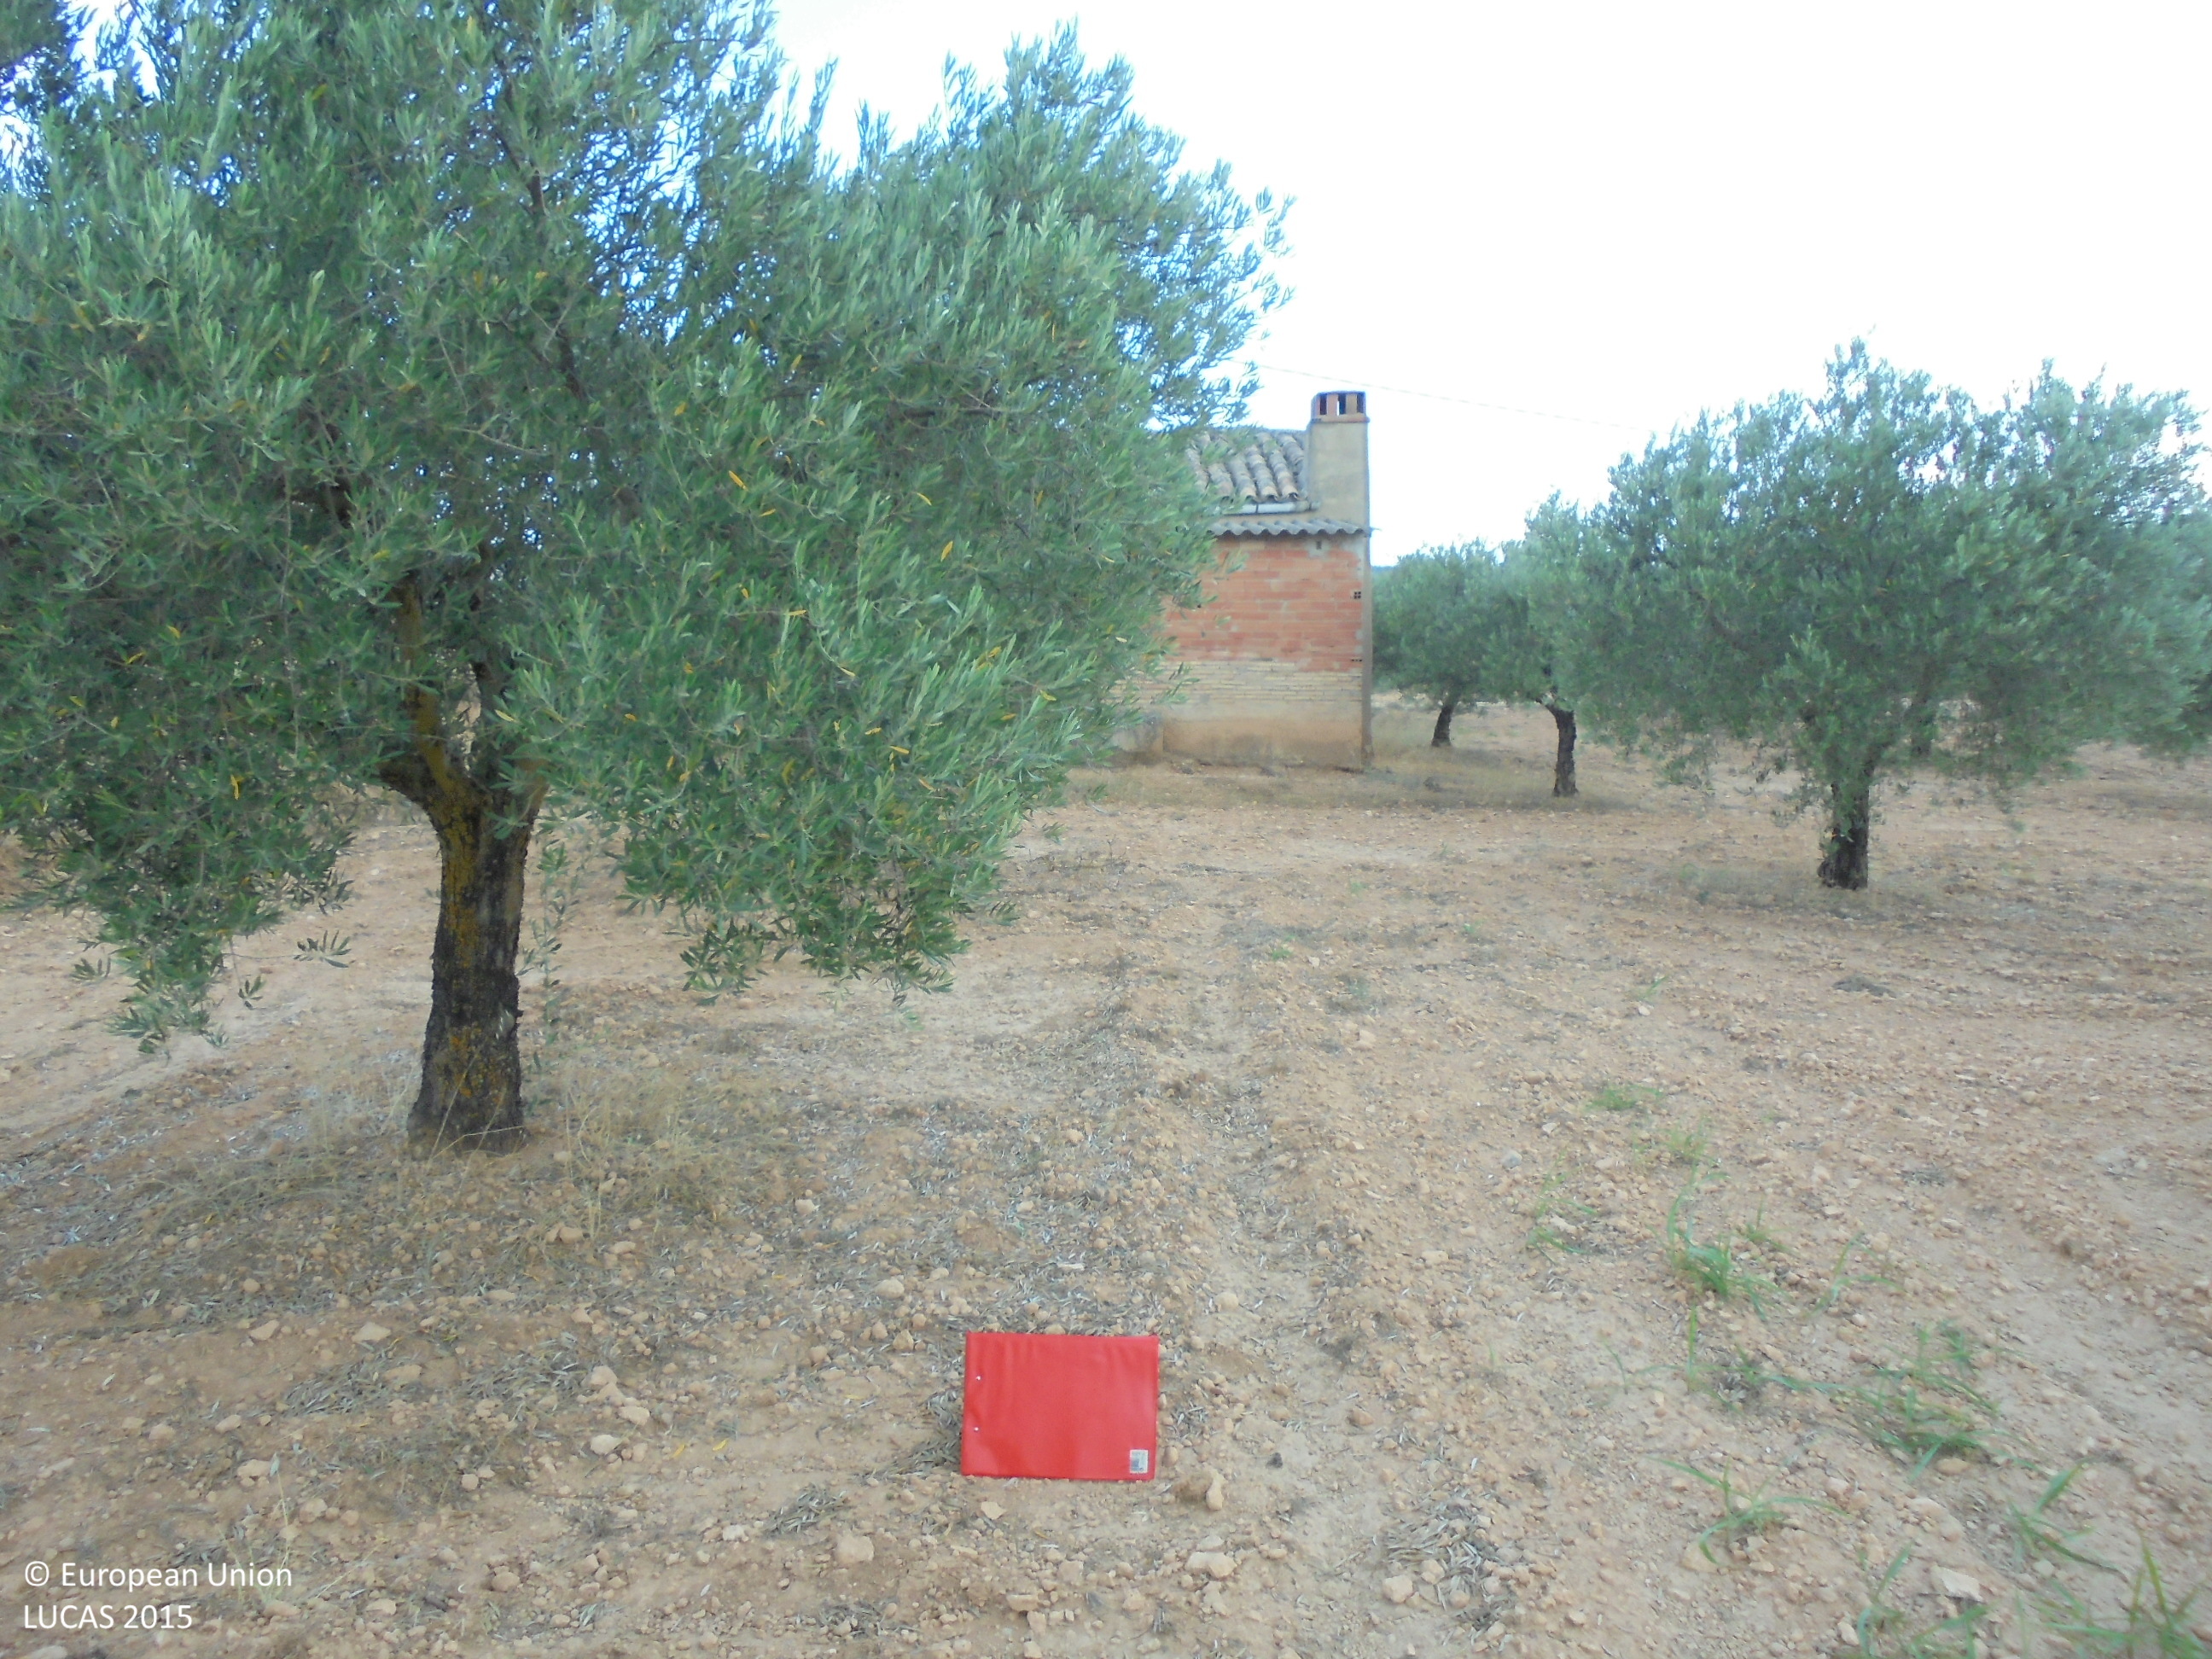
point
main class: Cropland
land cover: Olive groves
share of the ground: 25 - 50 %
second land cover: Other bare soil
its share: > 75 %
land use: Agriculture (excluding fallow land and kitchen gardens)
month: July
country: ES
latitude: 39.0591
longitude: -1.0323
